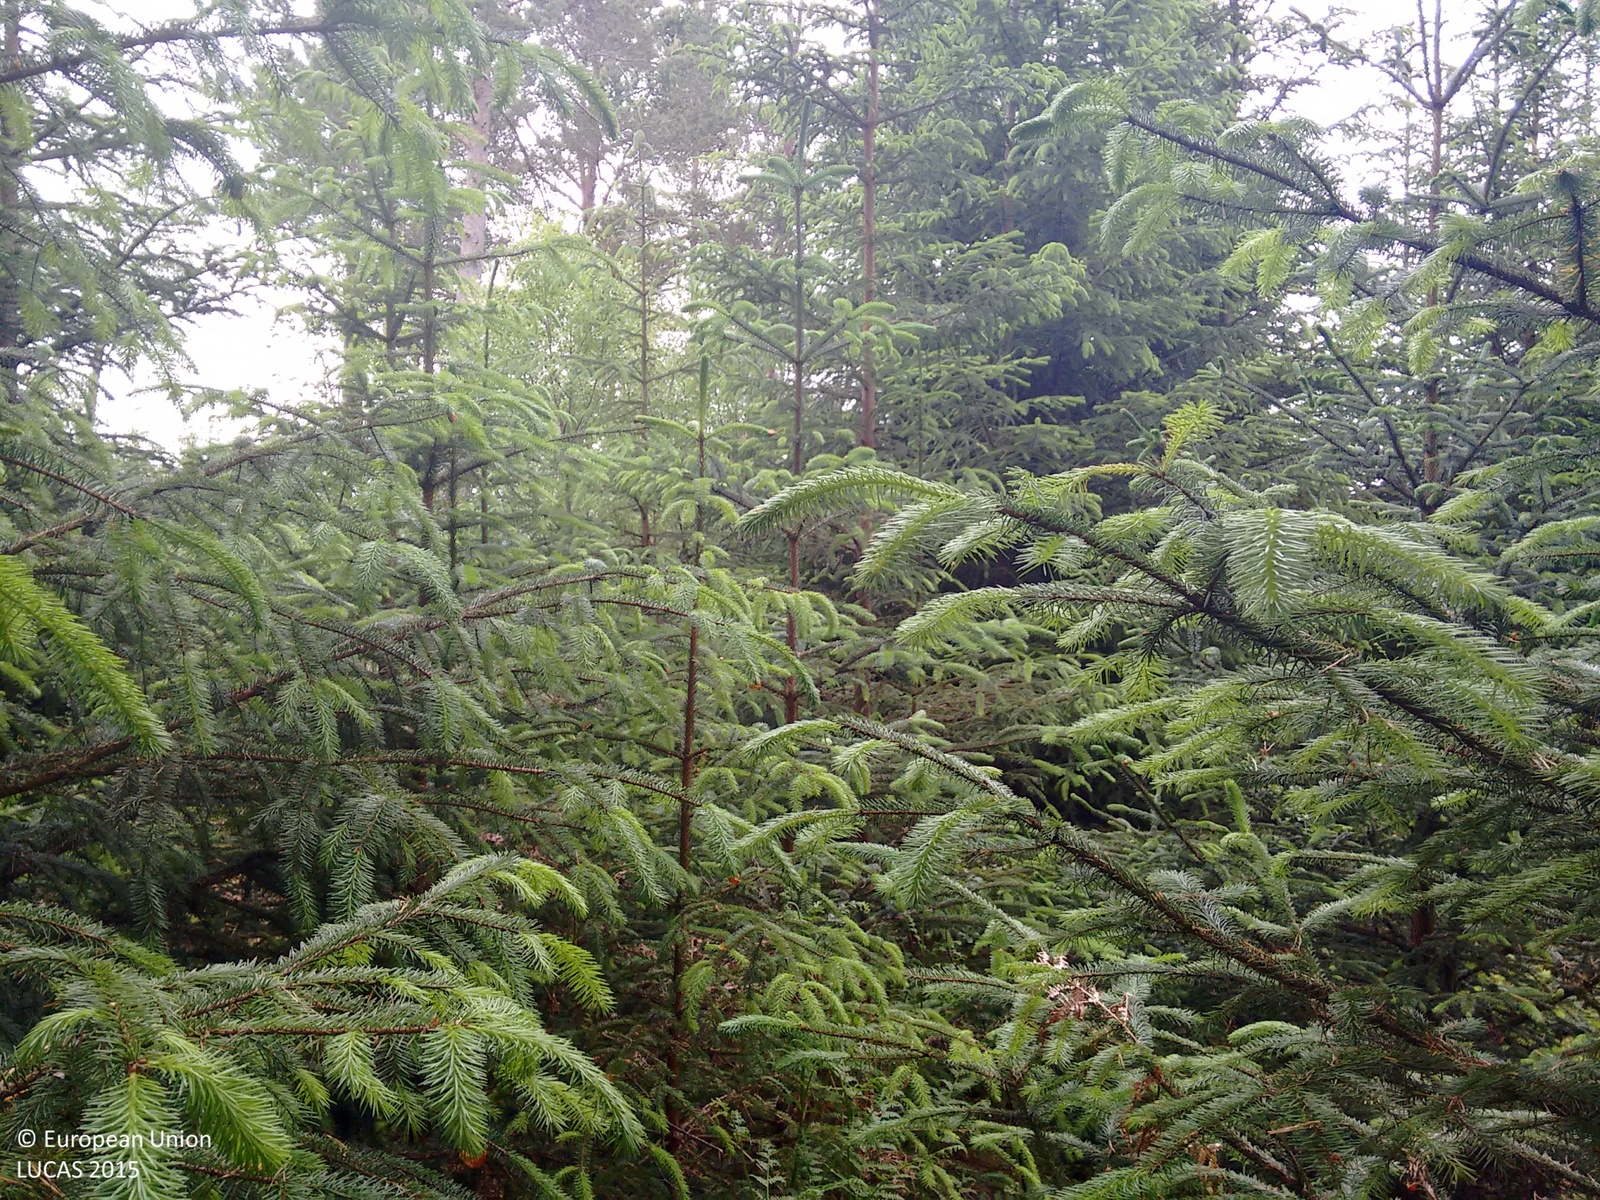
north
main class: Woodland
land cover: Spruce dominated coniferous woodland
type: exotic forest
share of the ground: > 75 %
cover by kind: coniferous forest trees 85 %, broadleaved forest trees 15 %
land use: Forestry
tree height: > 5 m
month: July
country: GB
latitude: 56.6829
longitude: -4.2758
